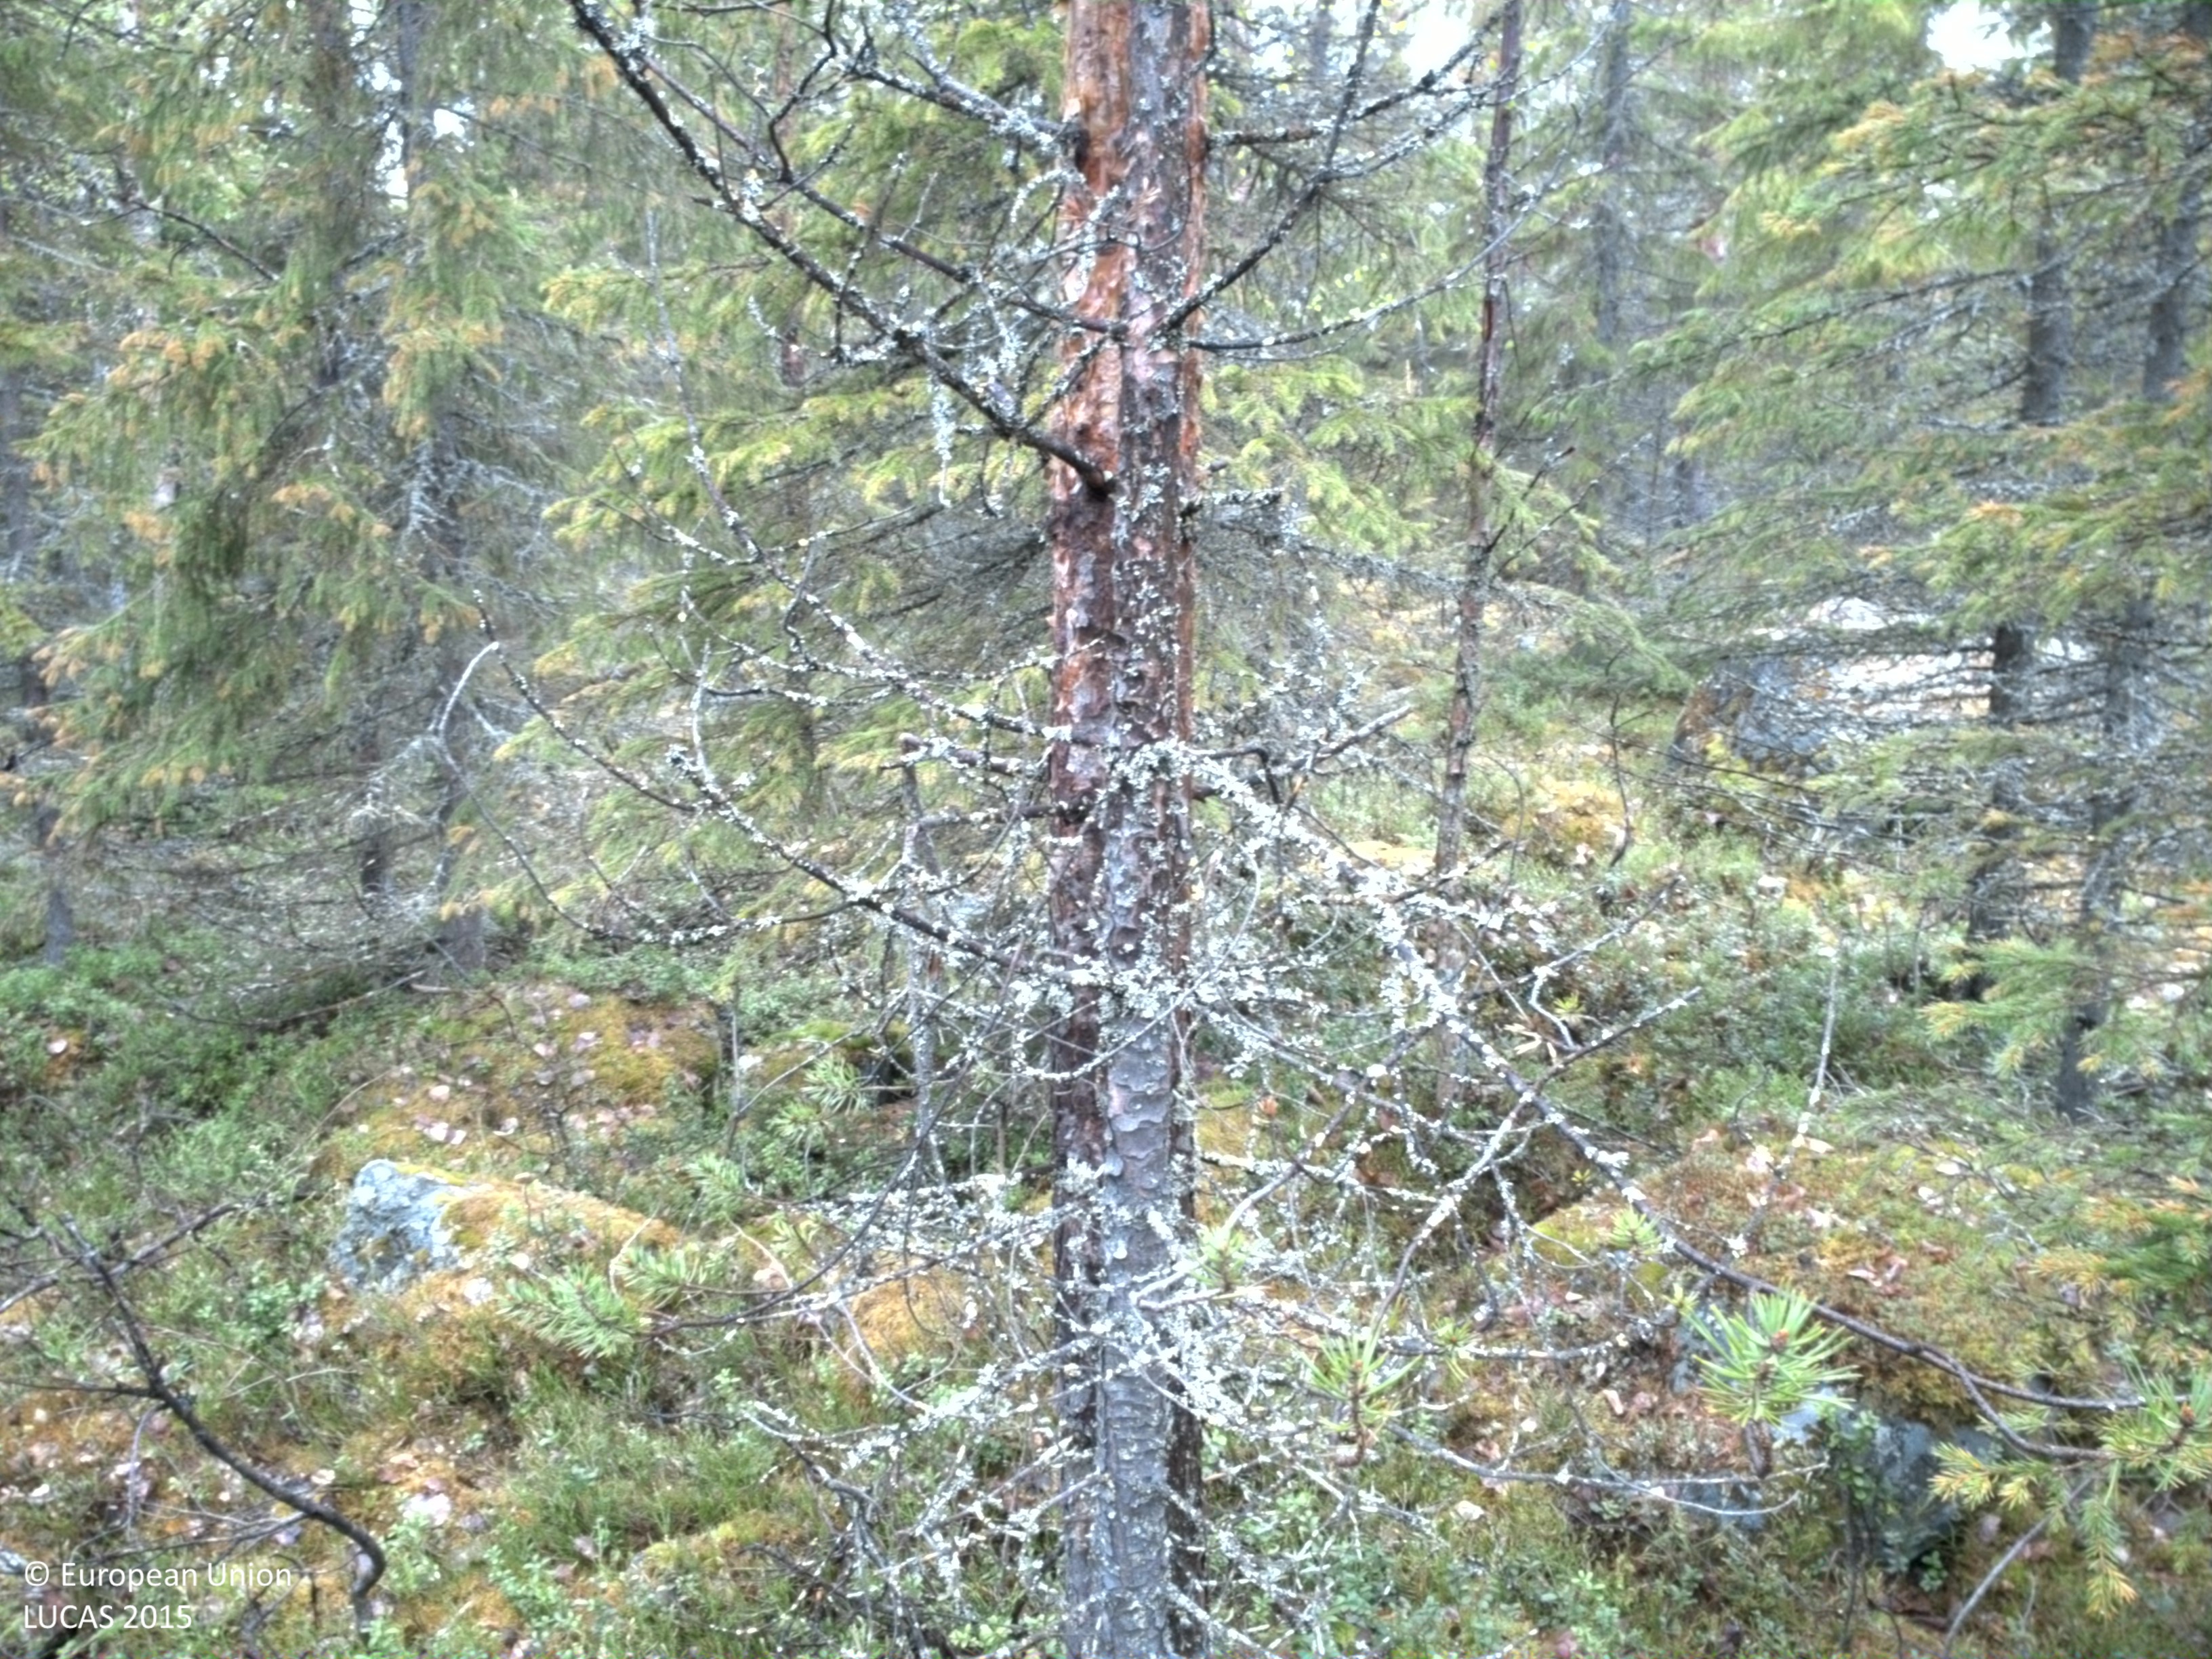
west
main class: Woodland
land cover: Spruce dominated coniferous woodland
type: boreal forest
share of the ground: > 75 %
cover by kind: coniferous forest trees 85 %, shrubs 10 %, lichens and mosses 5 %
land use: Forestry
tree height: > 5 m
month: May
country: SE
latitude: 66.0913
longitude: 23.1416
